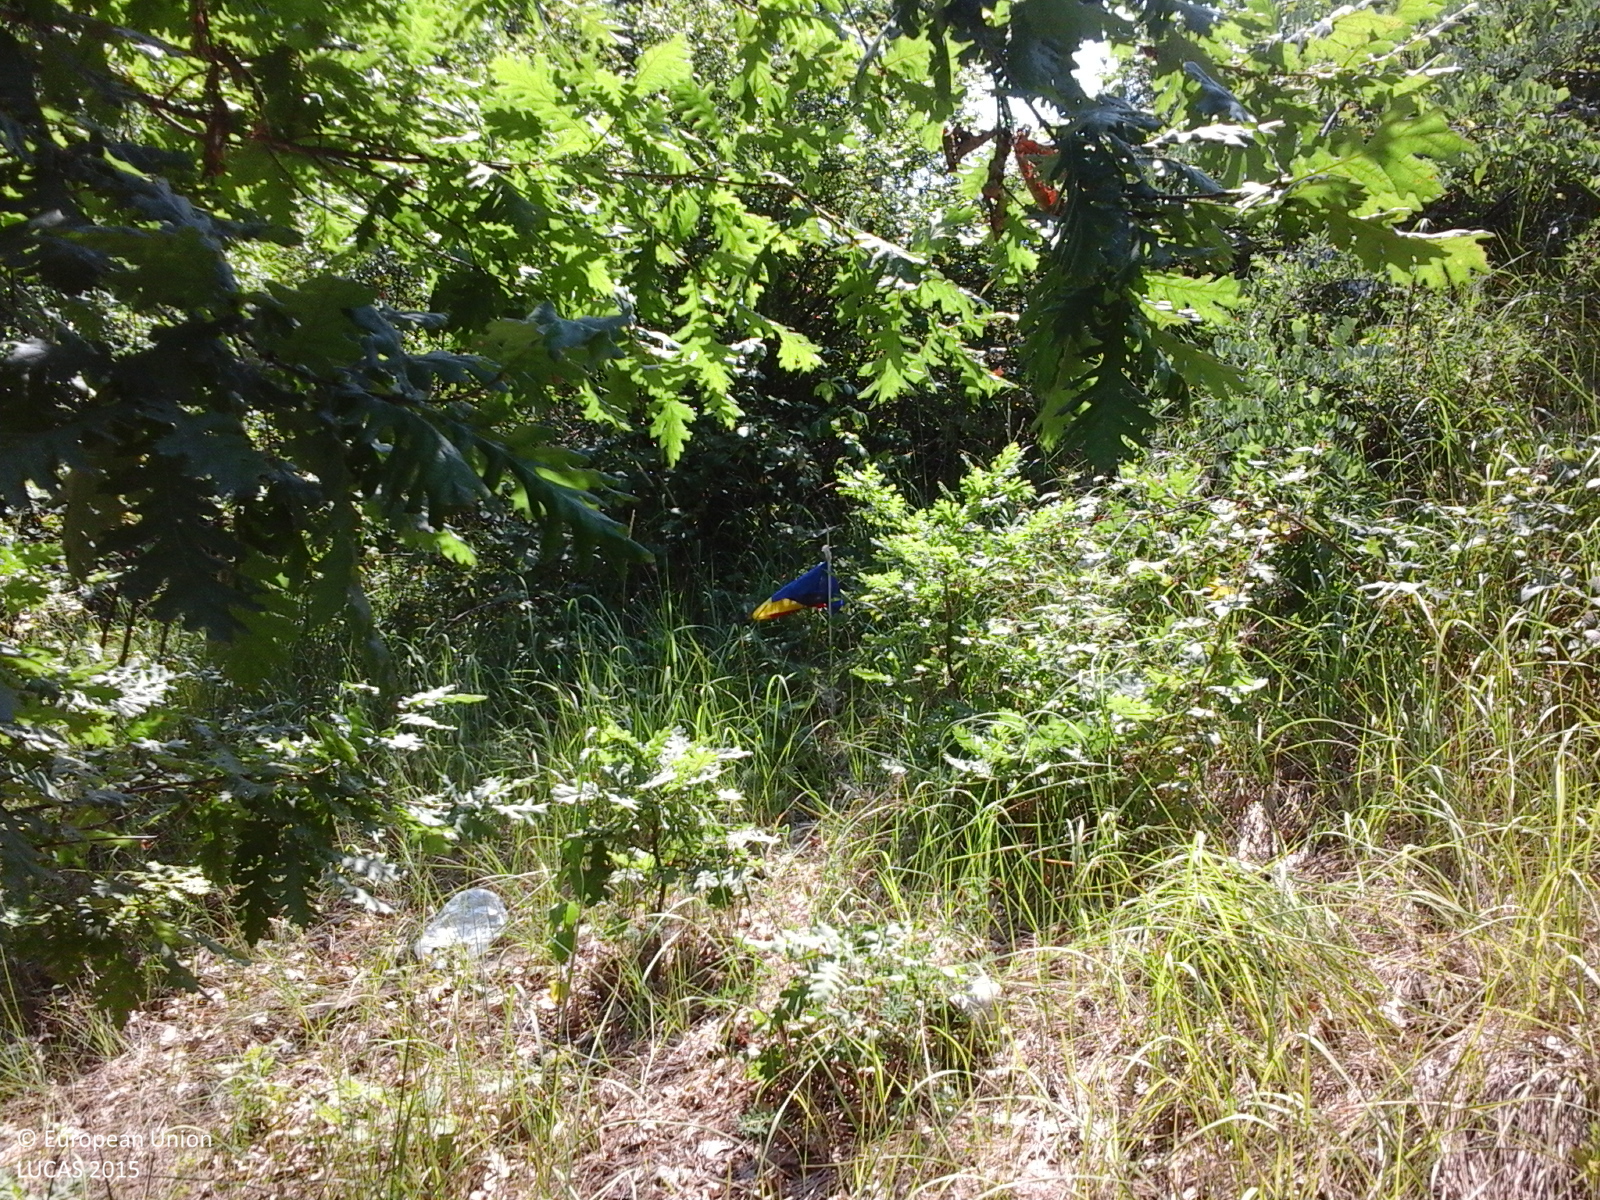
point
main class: Woodland
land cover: Broadleaved woodland
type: acidophilous oak and oak-birch forest
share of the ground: > 75 %
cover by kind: broadleaved forest trees 80 %, shrubs 10 %, herbaceous plants 10 %
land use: Forestry
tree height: > 5 m
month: July
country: RO
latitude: 44.7234
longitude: 24.5811
